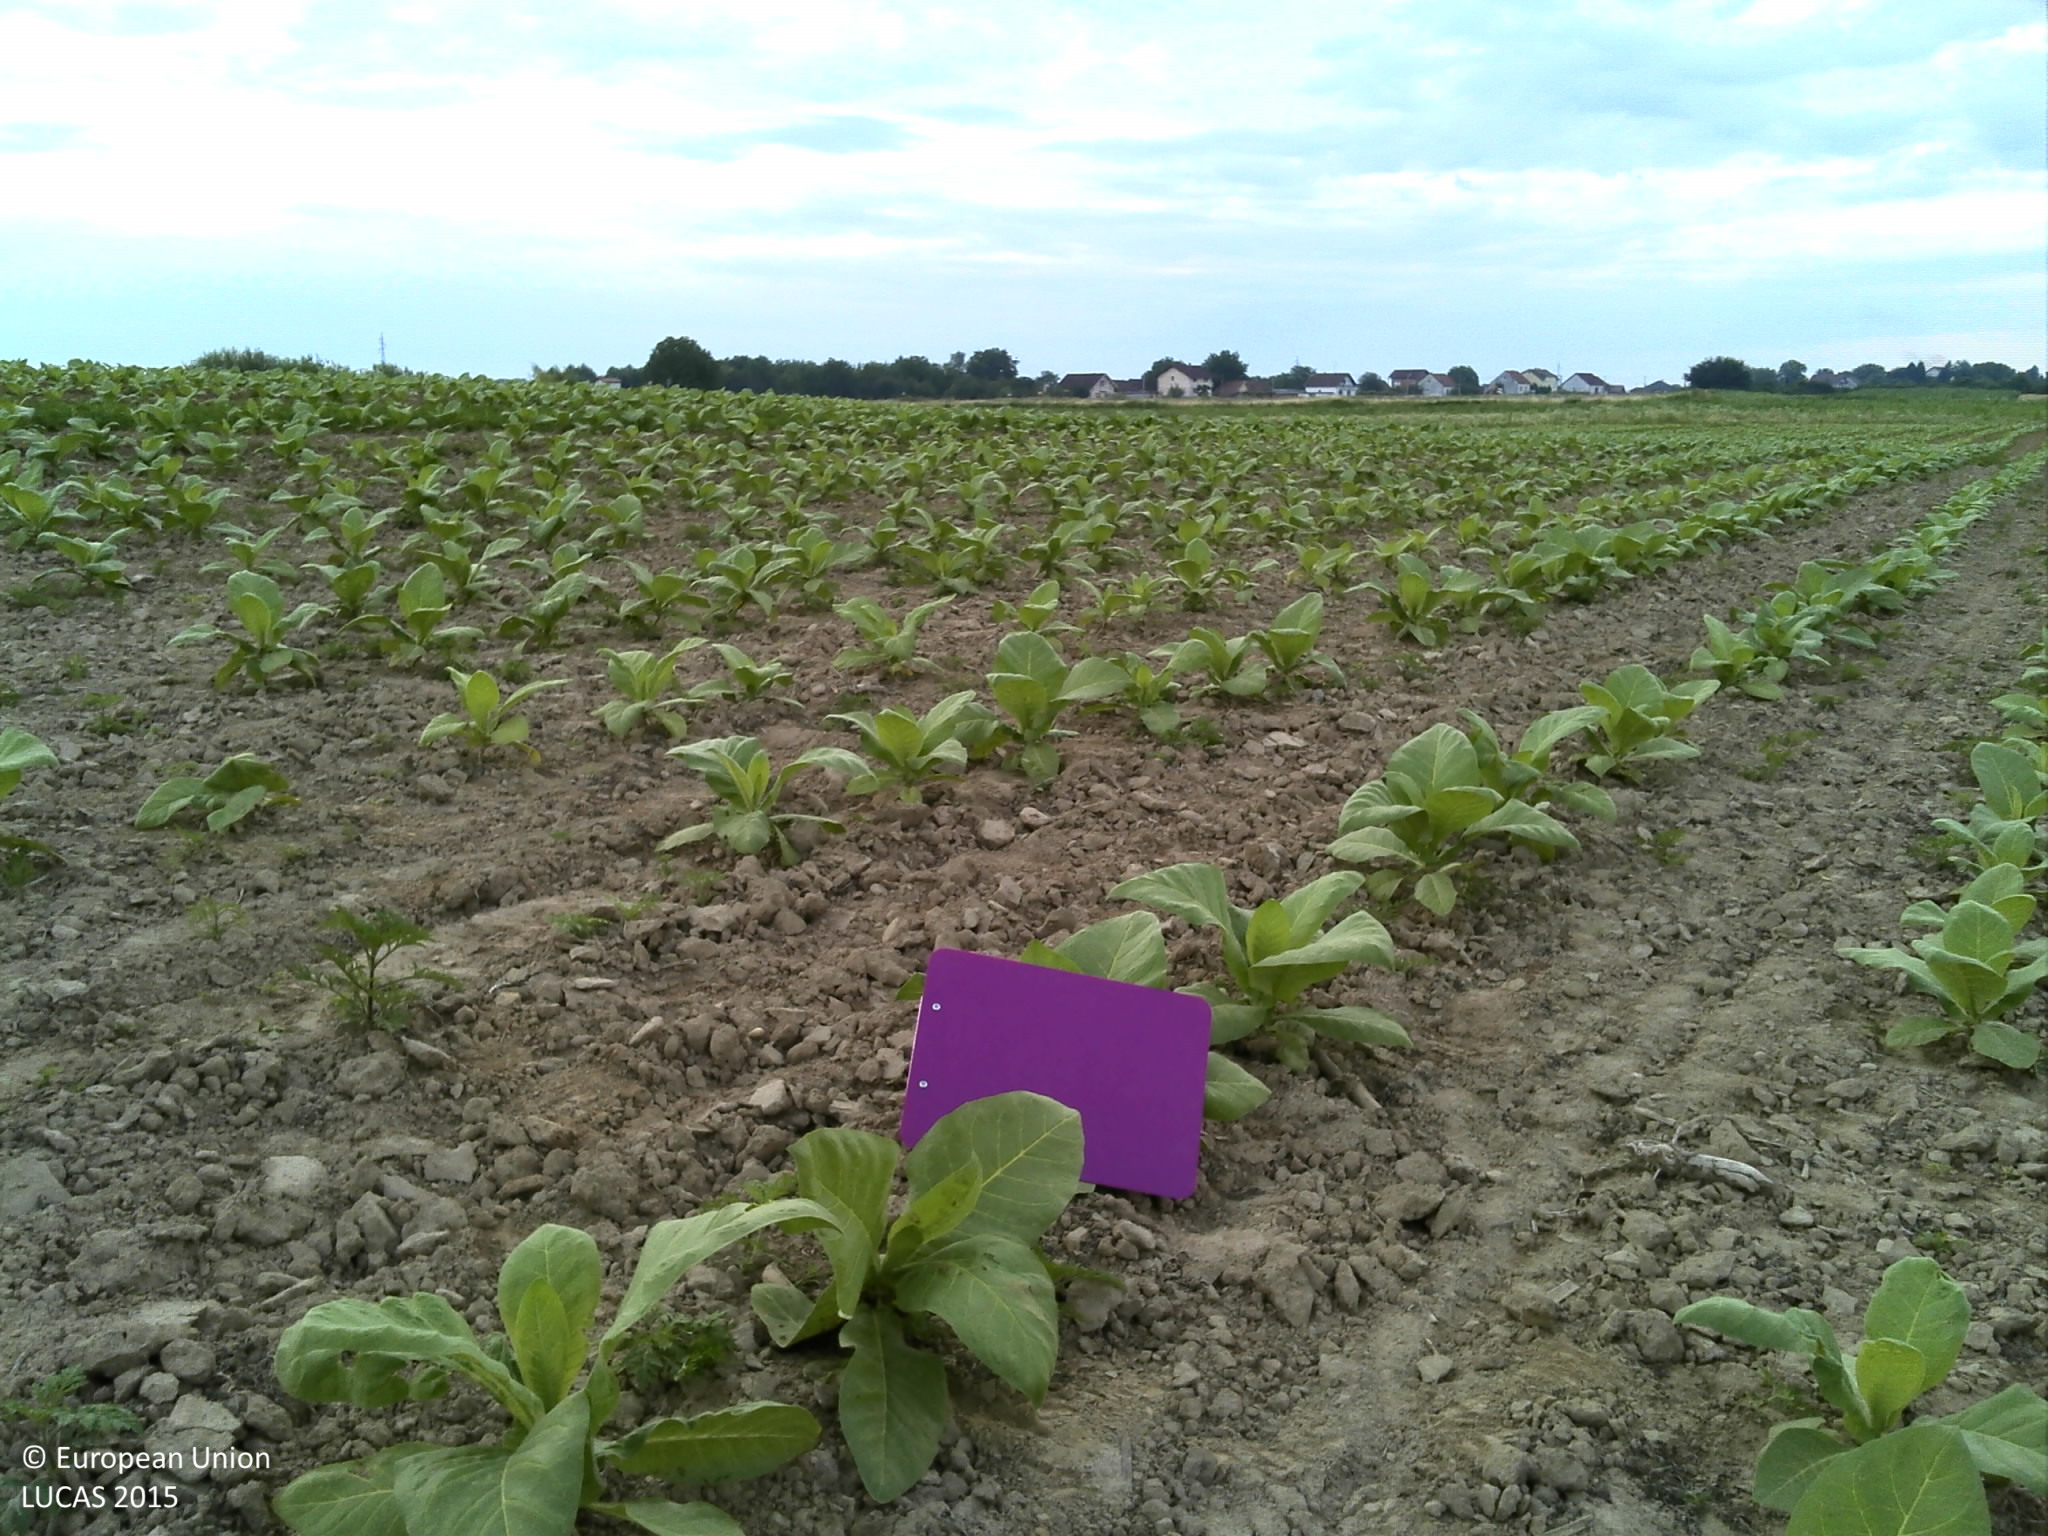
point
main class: Cropland
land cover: Sugar beet
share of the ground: < 10 %
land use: Agriculture (excluding fallow land and kitchen gardens)
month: June
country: HR
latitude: 45.7765
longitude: 17.5520
